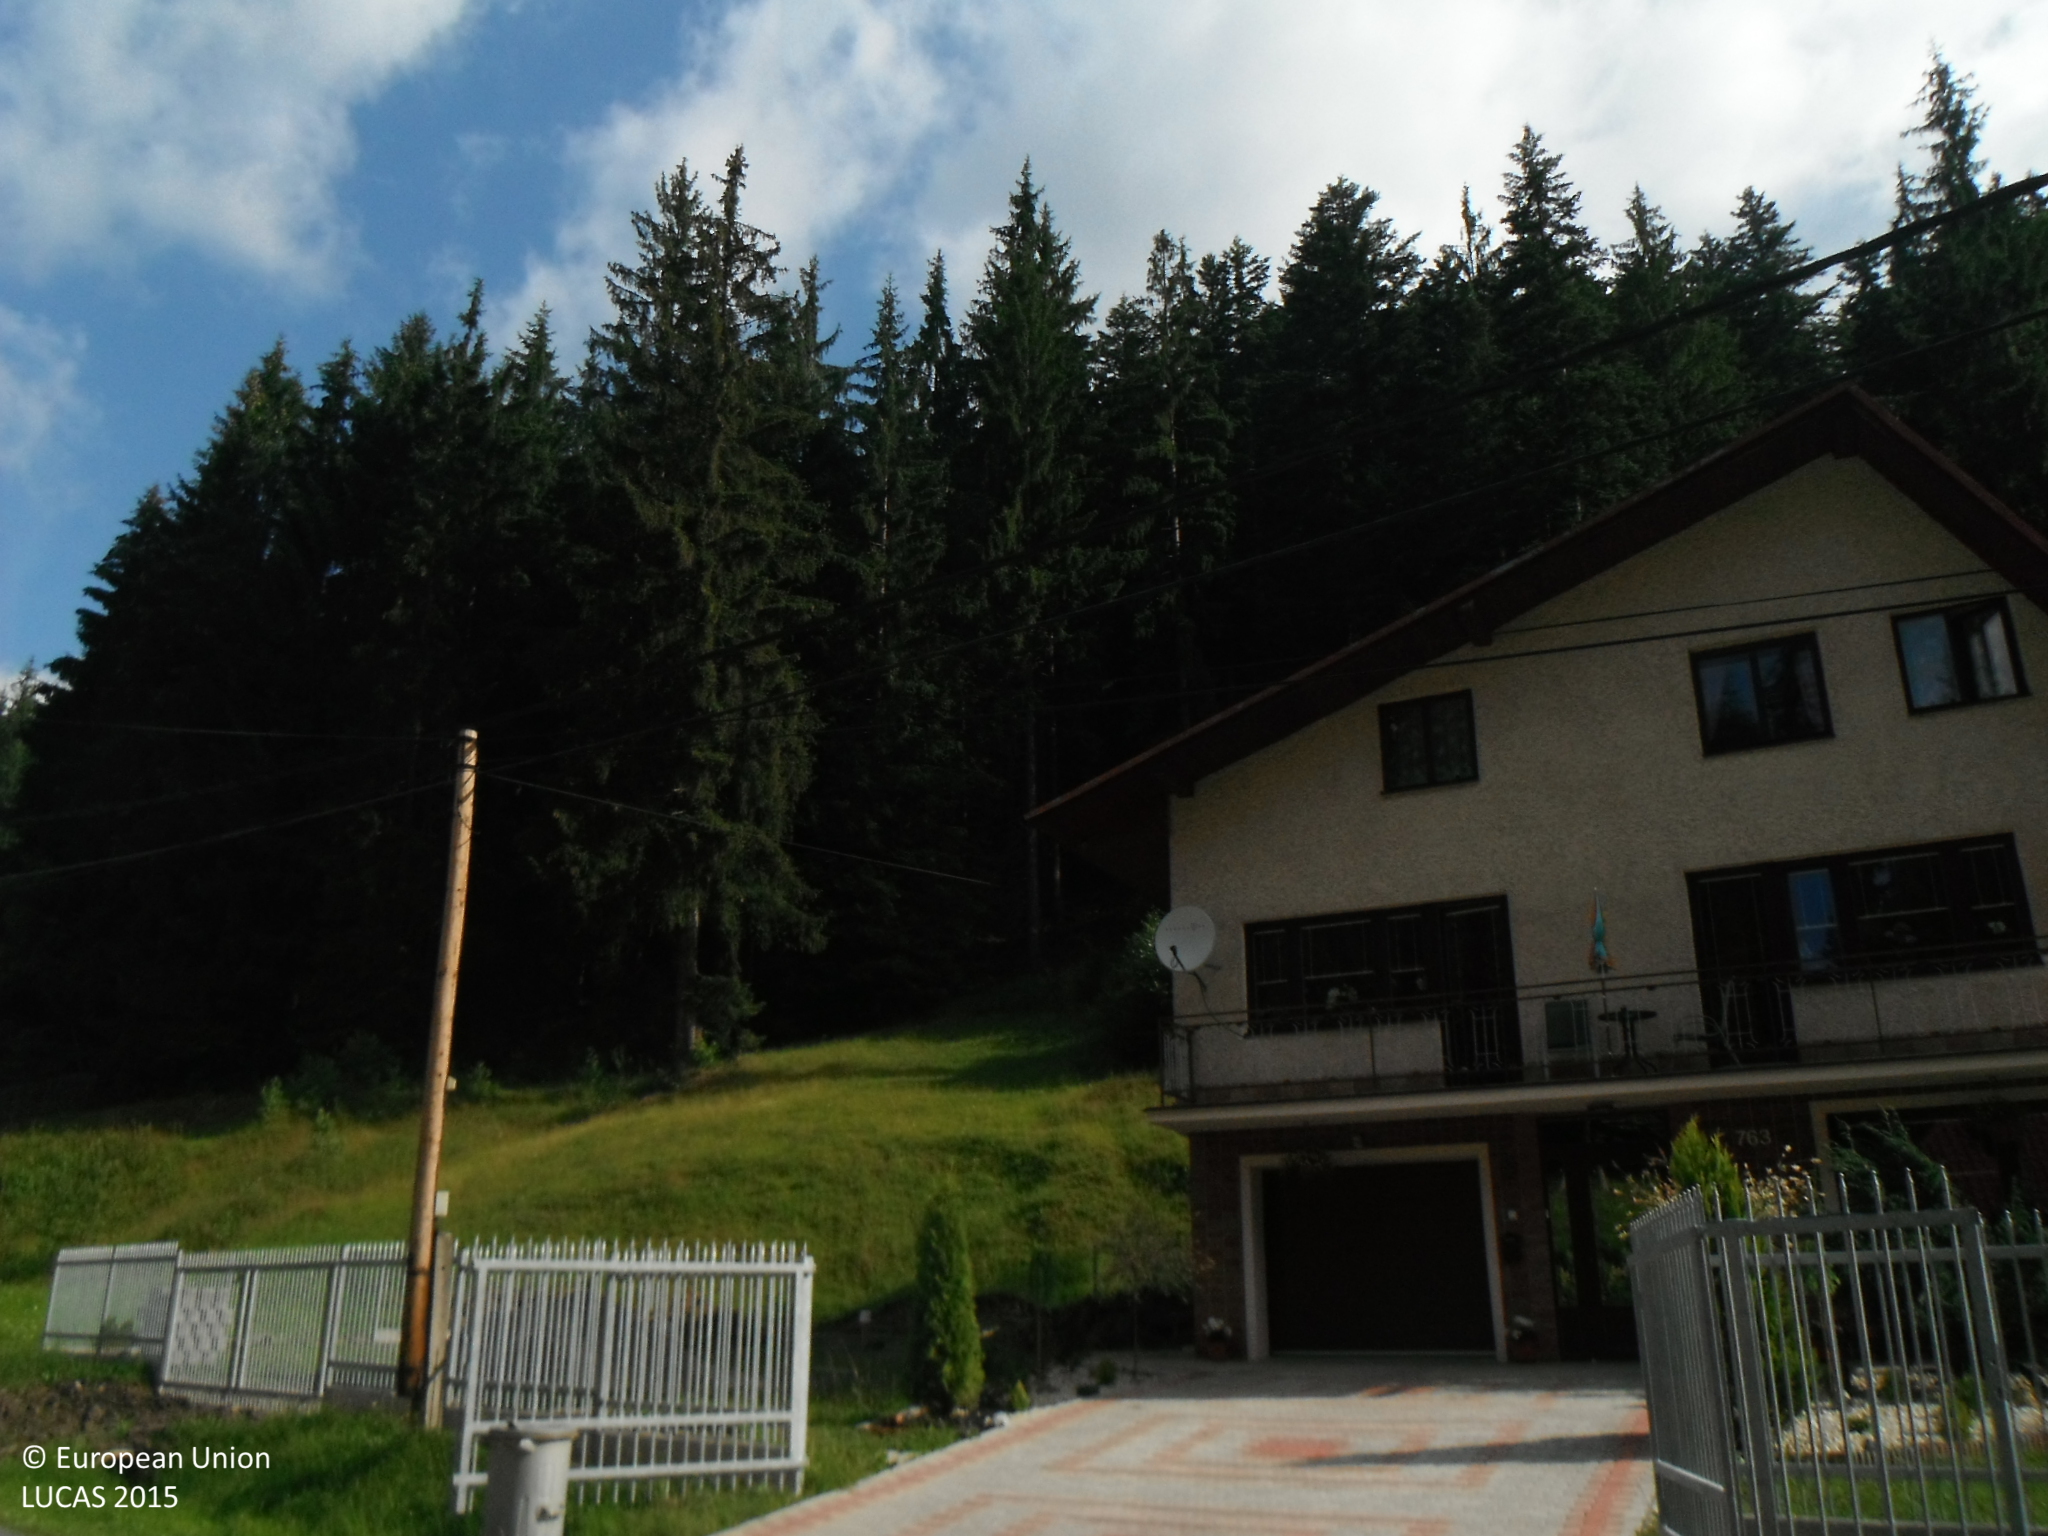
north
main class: Grassland
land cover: Grassland without tree/shrub cover
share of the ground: > 75 %
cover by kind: herbaceous plants 95 %
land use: Residential
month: July
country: SK
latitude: 49.4304
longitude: 18.5260
